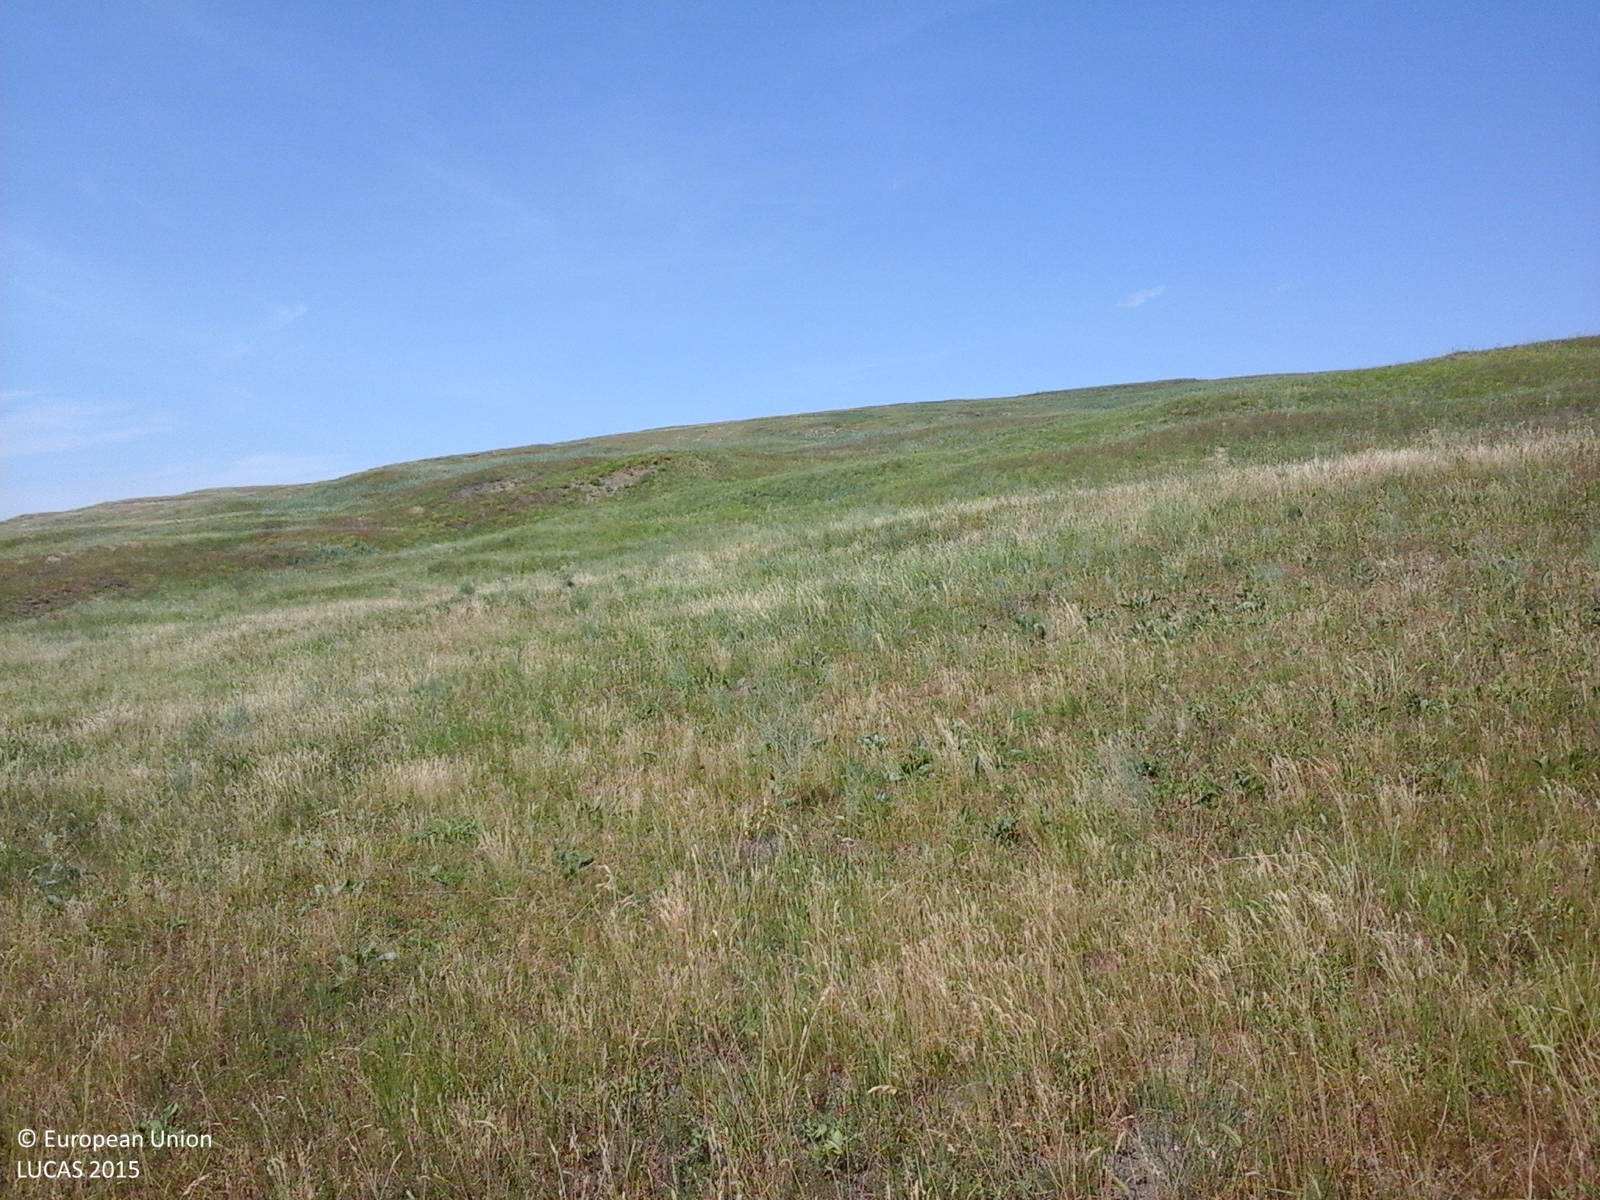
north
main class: Grassland
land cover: Grassland without tree/shrub cover
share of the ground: > 75 %
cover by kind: herbaceous plants 100 %
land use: Agriculture (excluding fallow land and kitchen gardens)
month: June
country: RO
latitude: 47.4833
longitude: 26.9696
